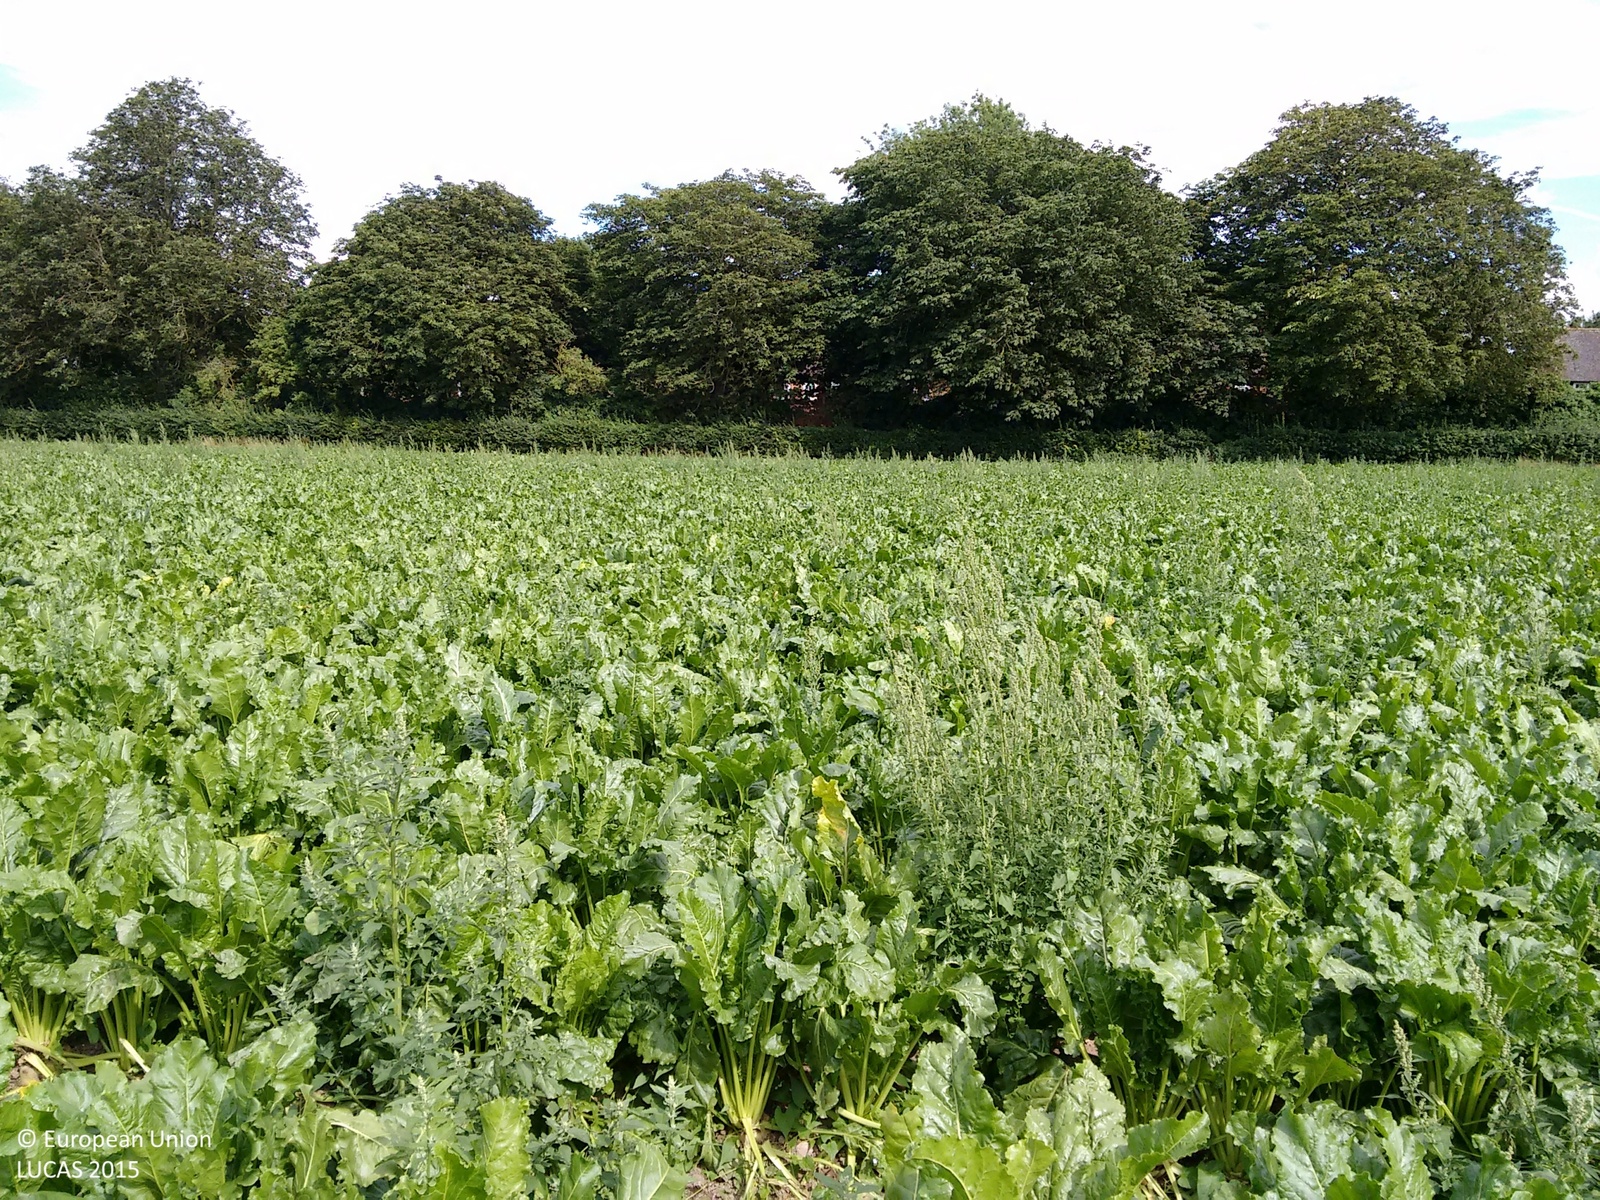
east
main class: Cropland
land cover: Sugar beet
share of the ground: > 75 %
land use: Agriculture (excluding fallow land and kitchen gardens)
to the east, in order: Sugar beet; Grass margins; Managed hedges; Artificial constructions in urban areas
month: August
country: GB
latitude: 52.4849
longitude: 0.5039
